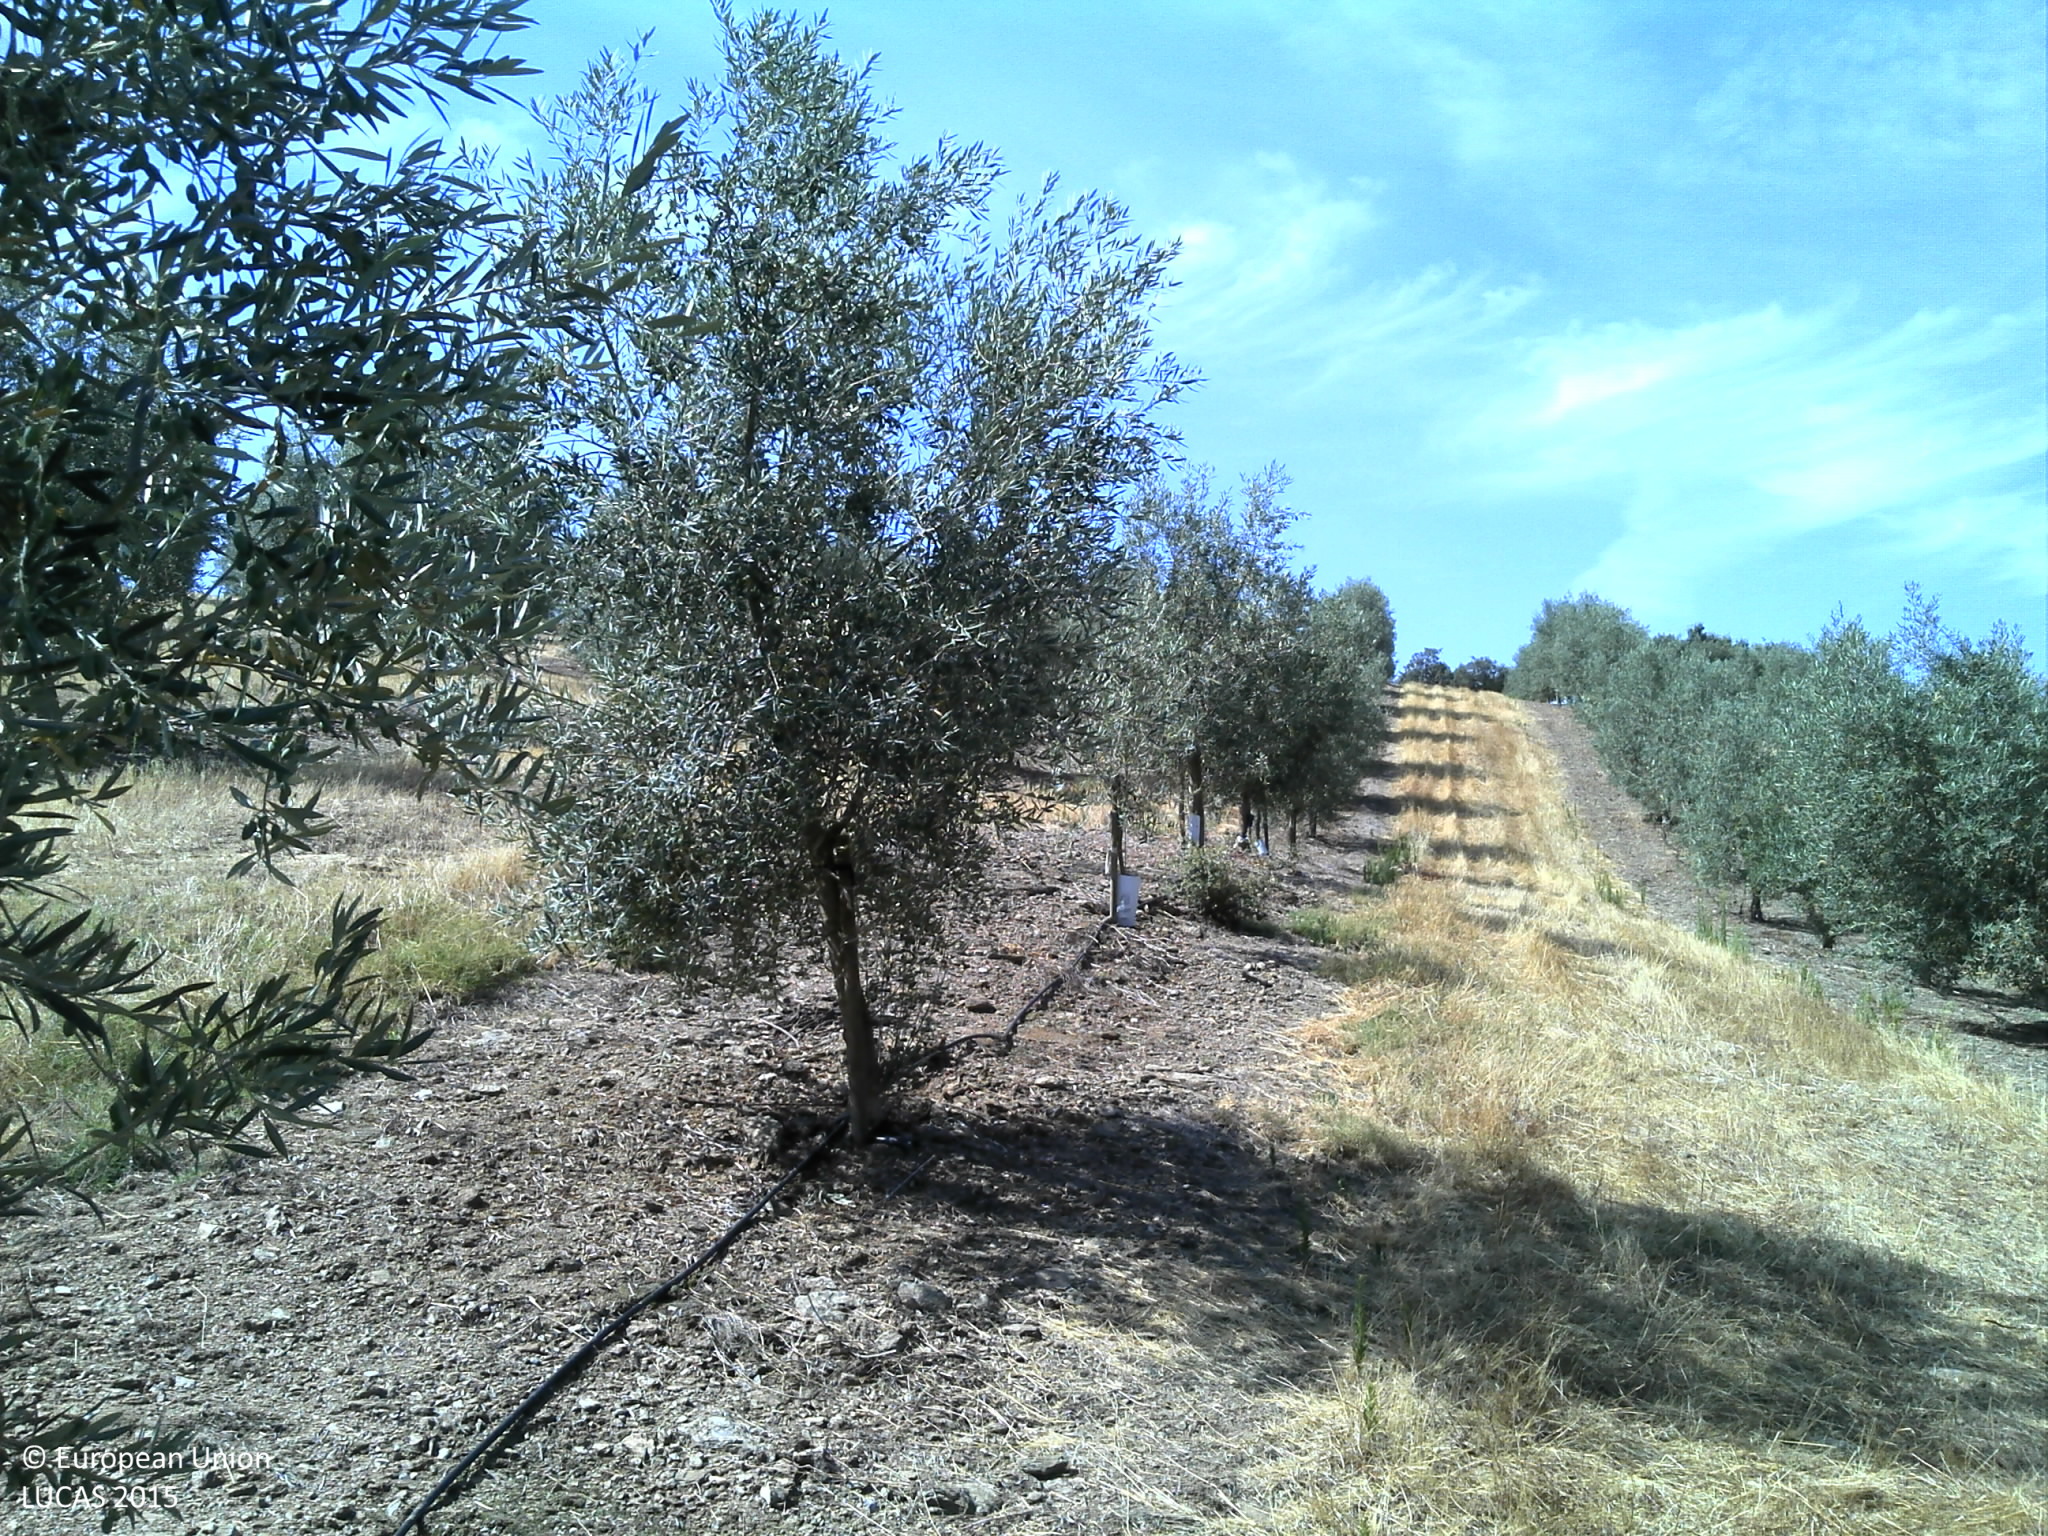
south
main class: Cropland
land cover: Olive groves
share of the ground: 10 - 25 %
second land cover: Grassland without tree/shrub cover
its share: 25 - 50 %
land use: Agriculture (excluding fallow land and kitchen gardens)
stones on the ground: < 10 %
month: July
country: PT
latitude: 38.4426
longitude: -7.6875
